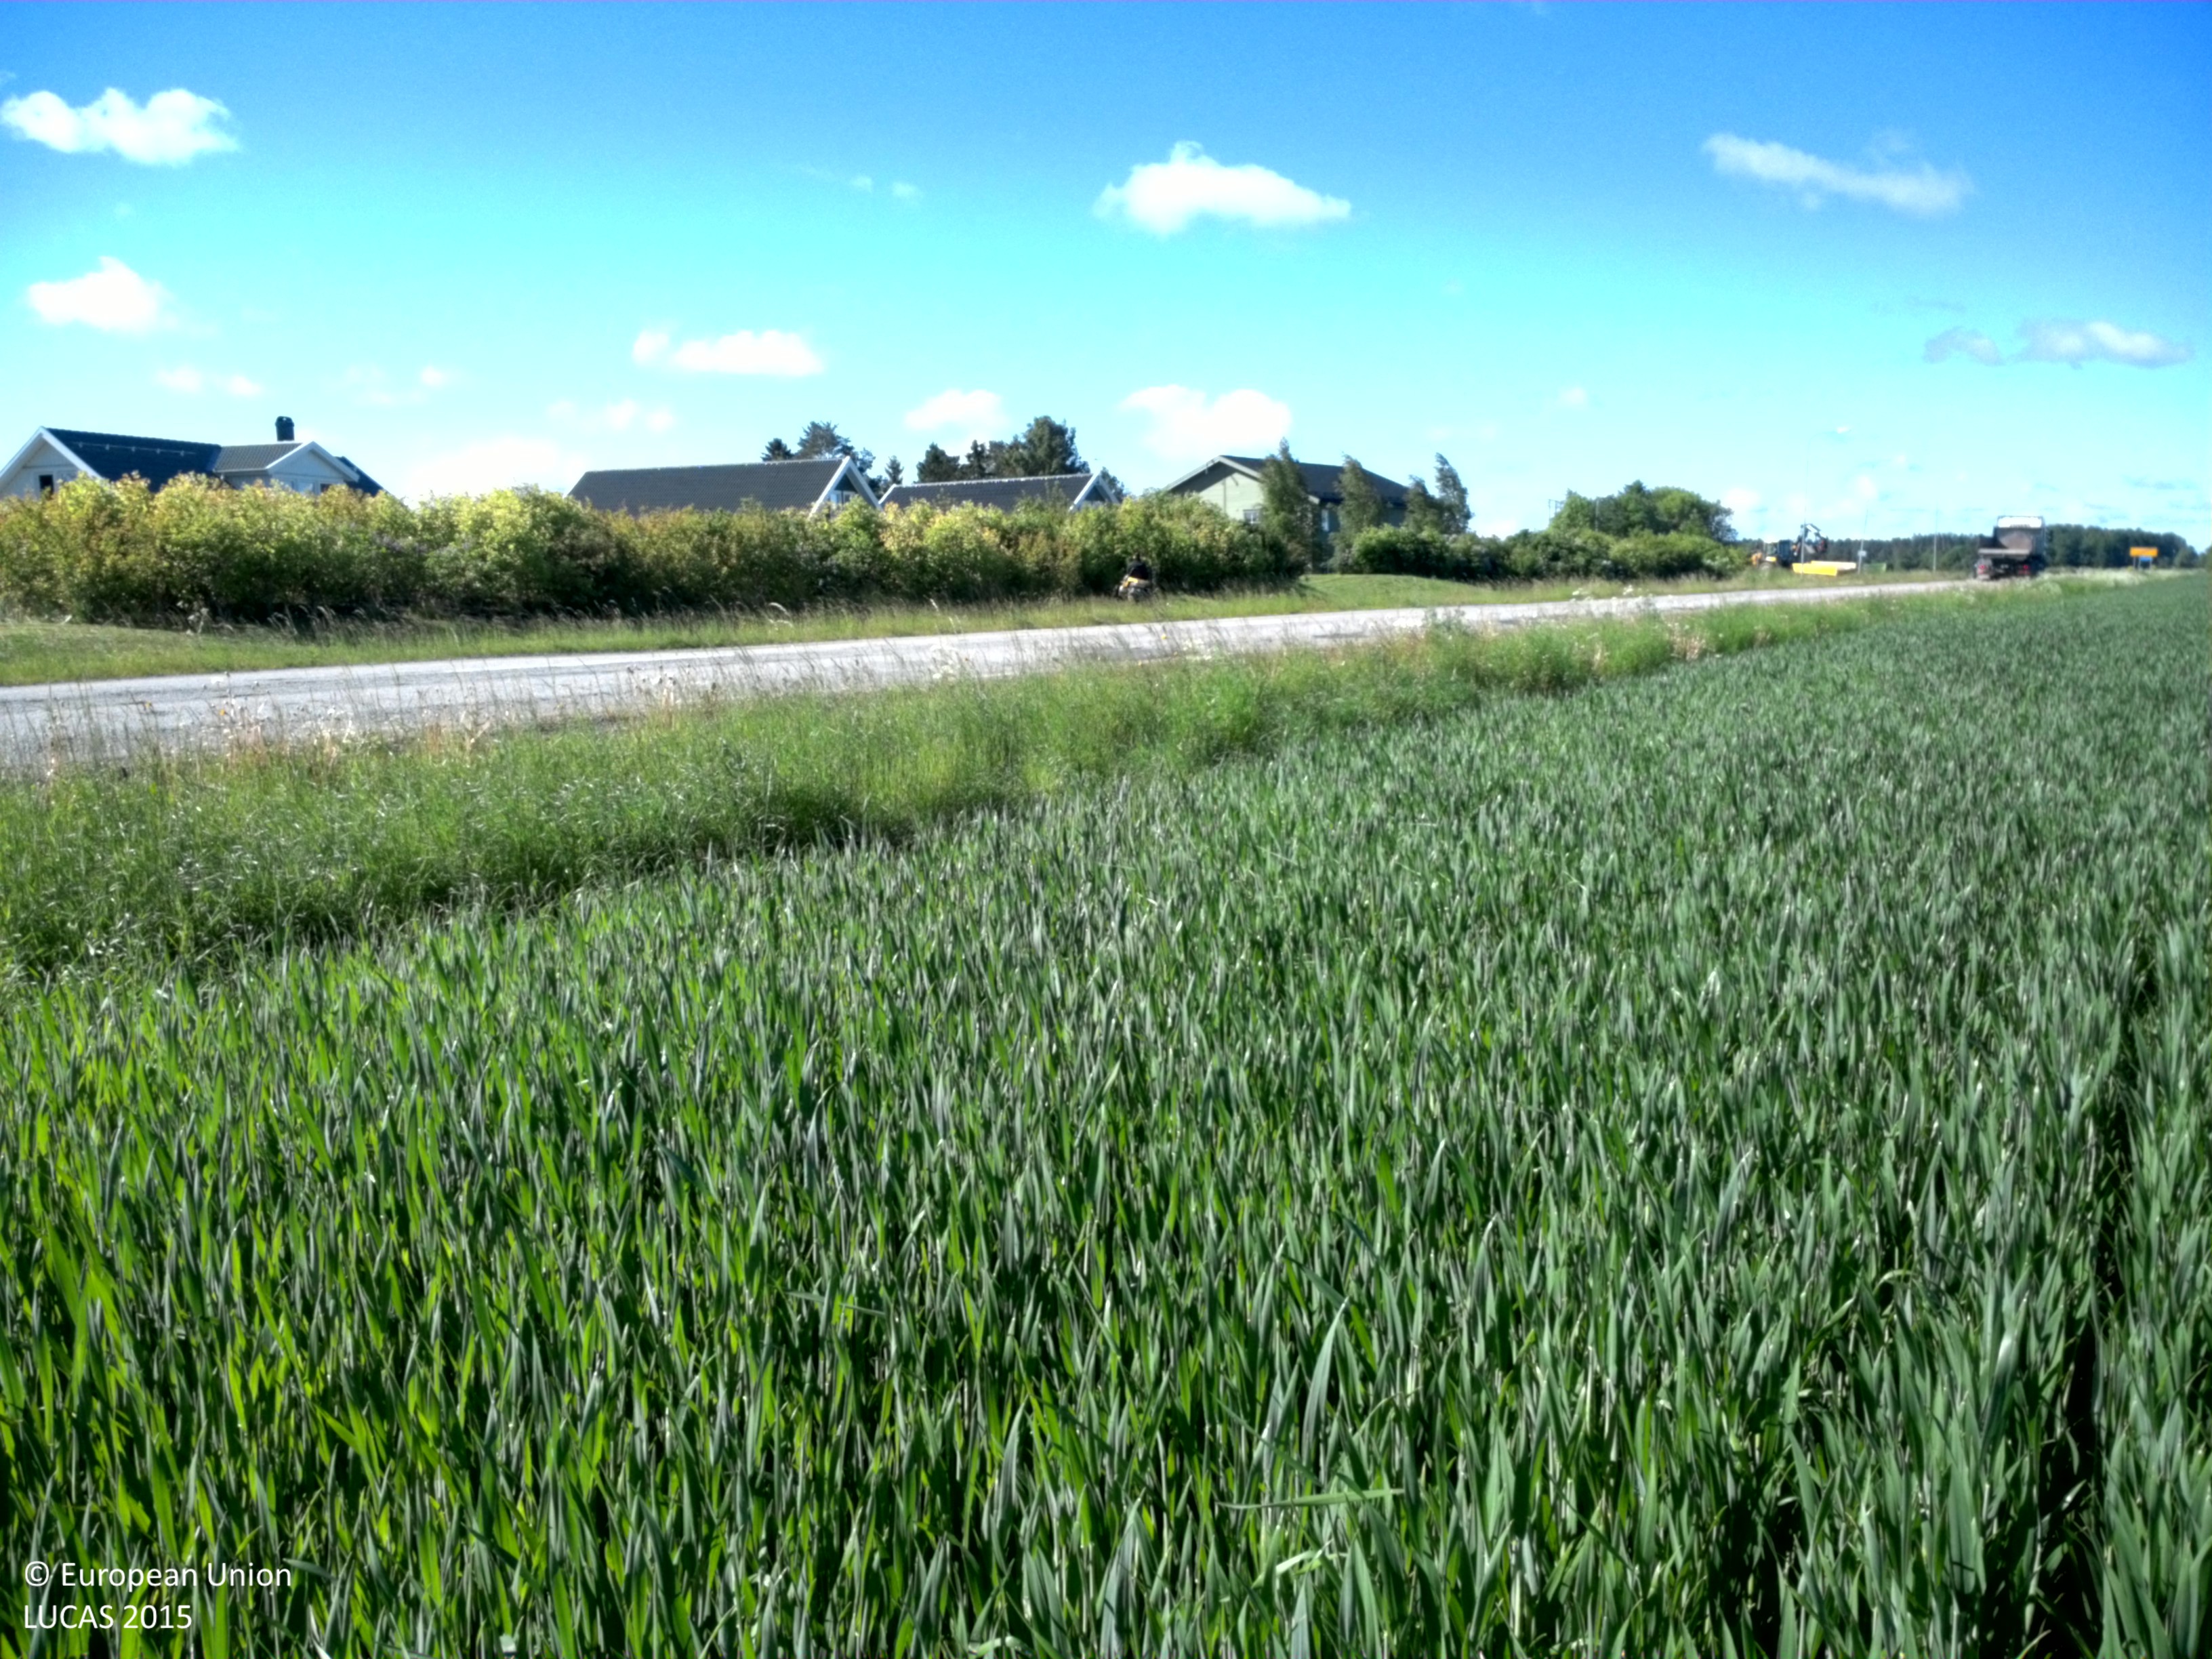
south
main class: Cropland
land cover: Common wheat
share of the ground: > 75 %
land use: Agriculture (excluding fallow land and kitchen gardens)
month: June
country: SE
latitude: 59.9592
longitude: 17.5688
